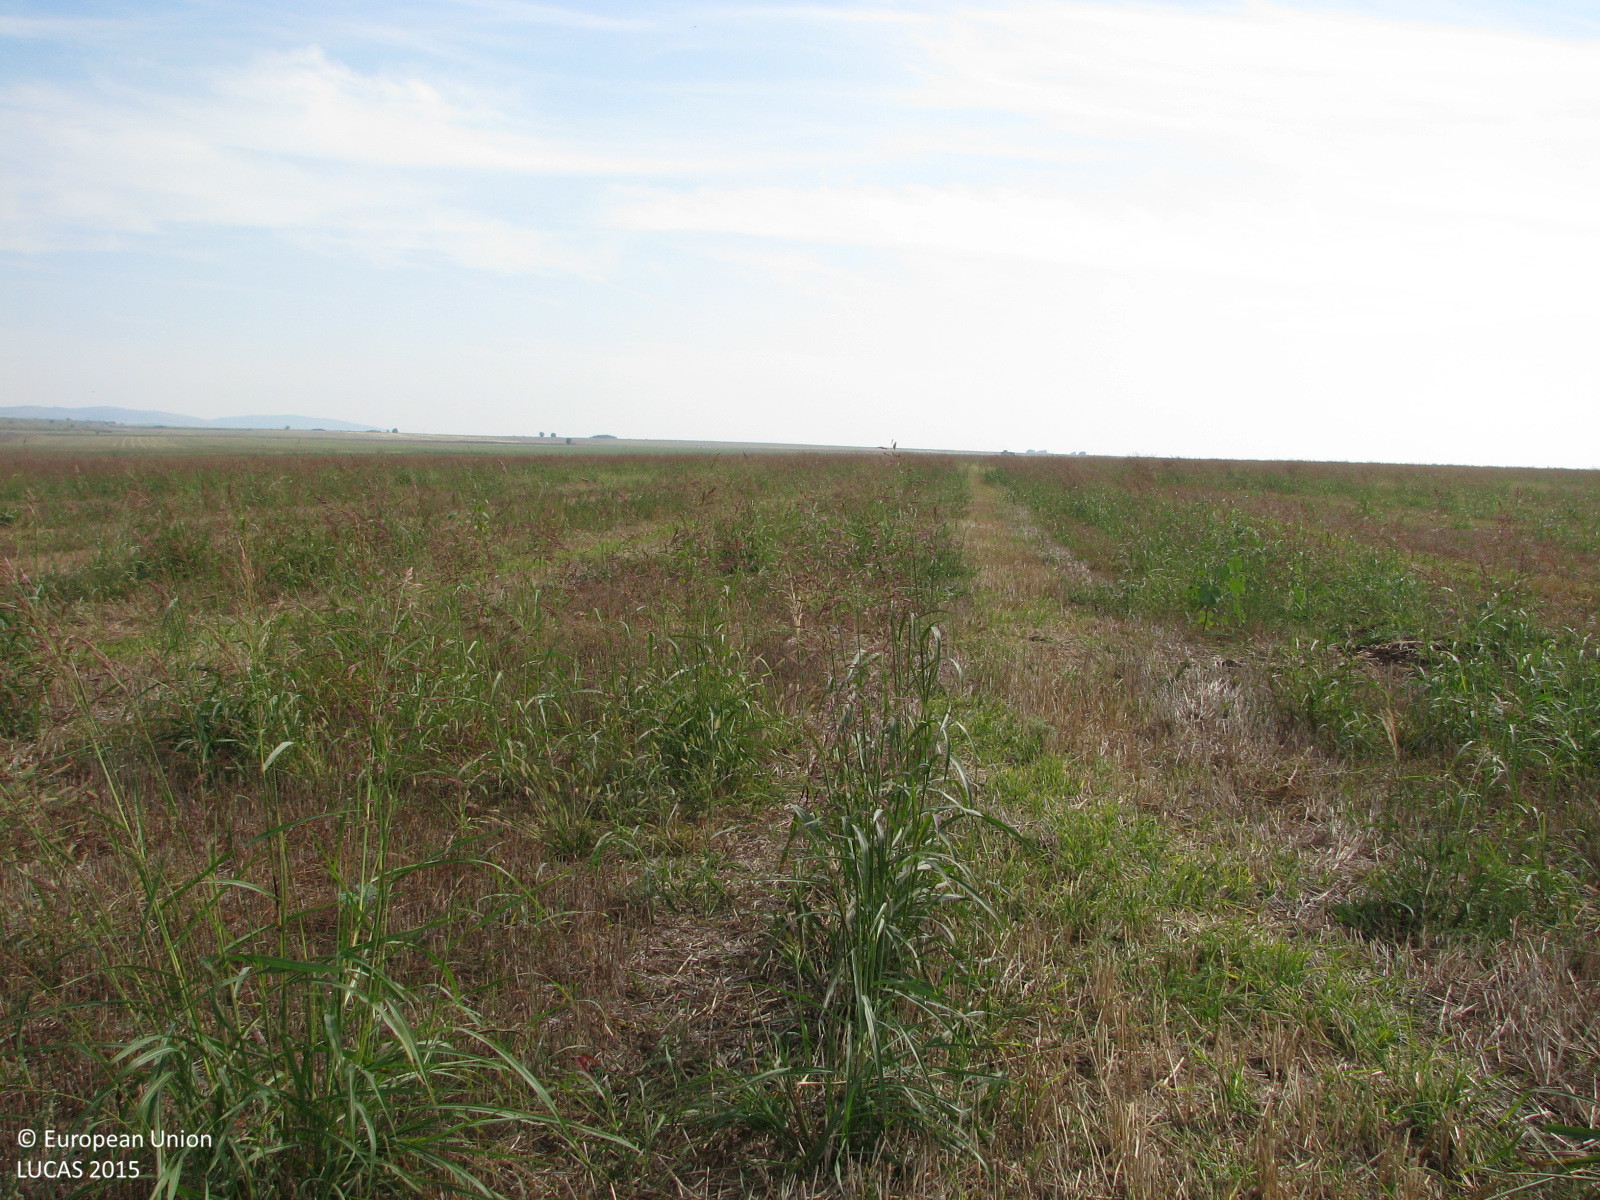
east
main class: Cropland
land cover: Oats
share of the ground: 50 - 75 %
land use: Agriculture (excluding fallow land and kitchen gardens)
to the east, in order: Oats
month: October
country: BG
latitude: 42.4178
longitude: 26.0121
